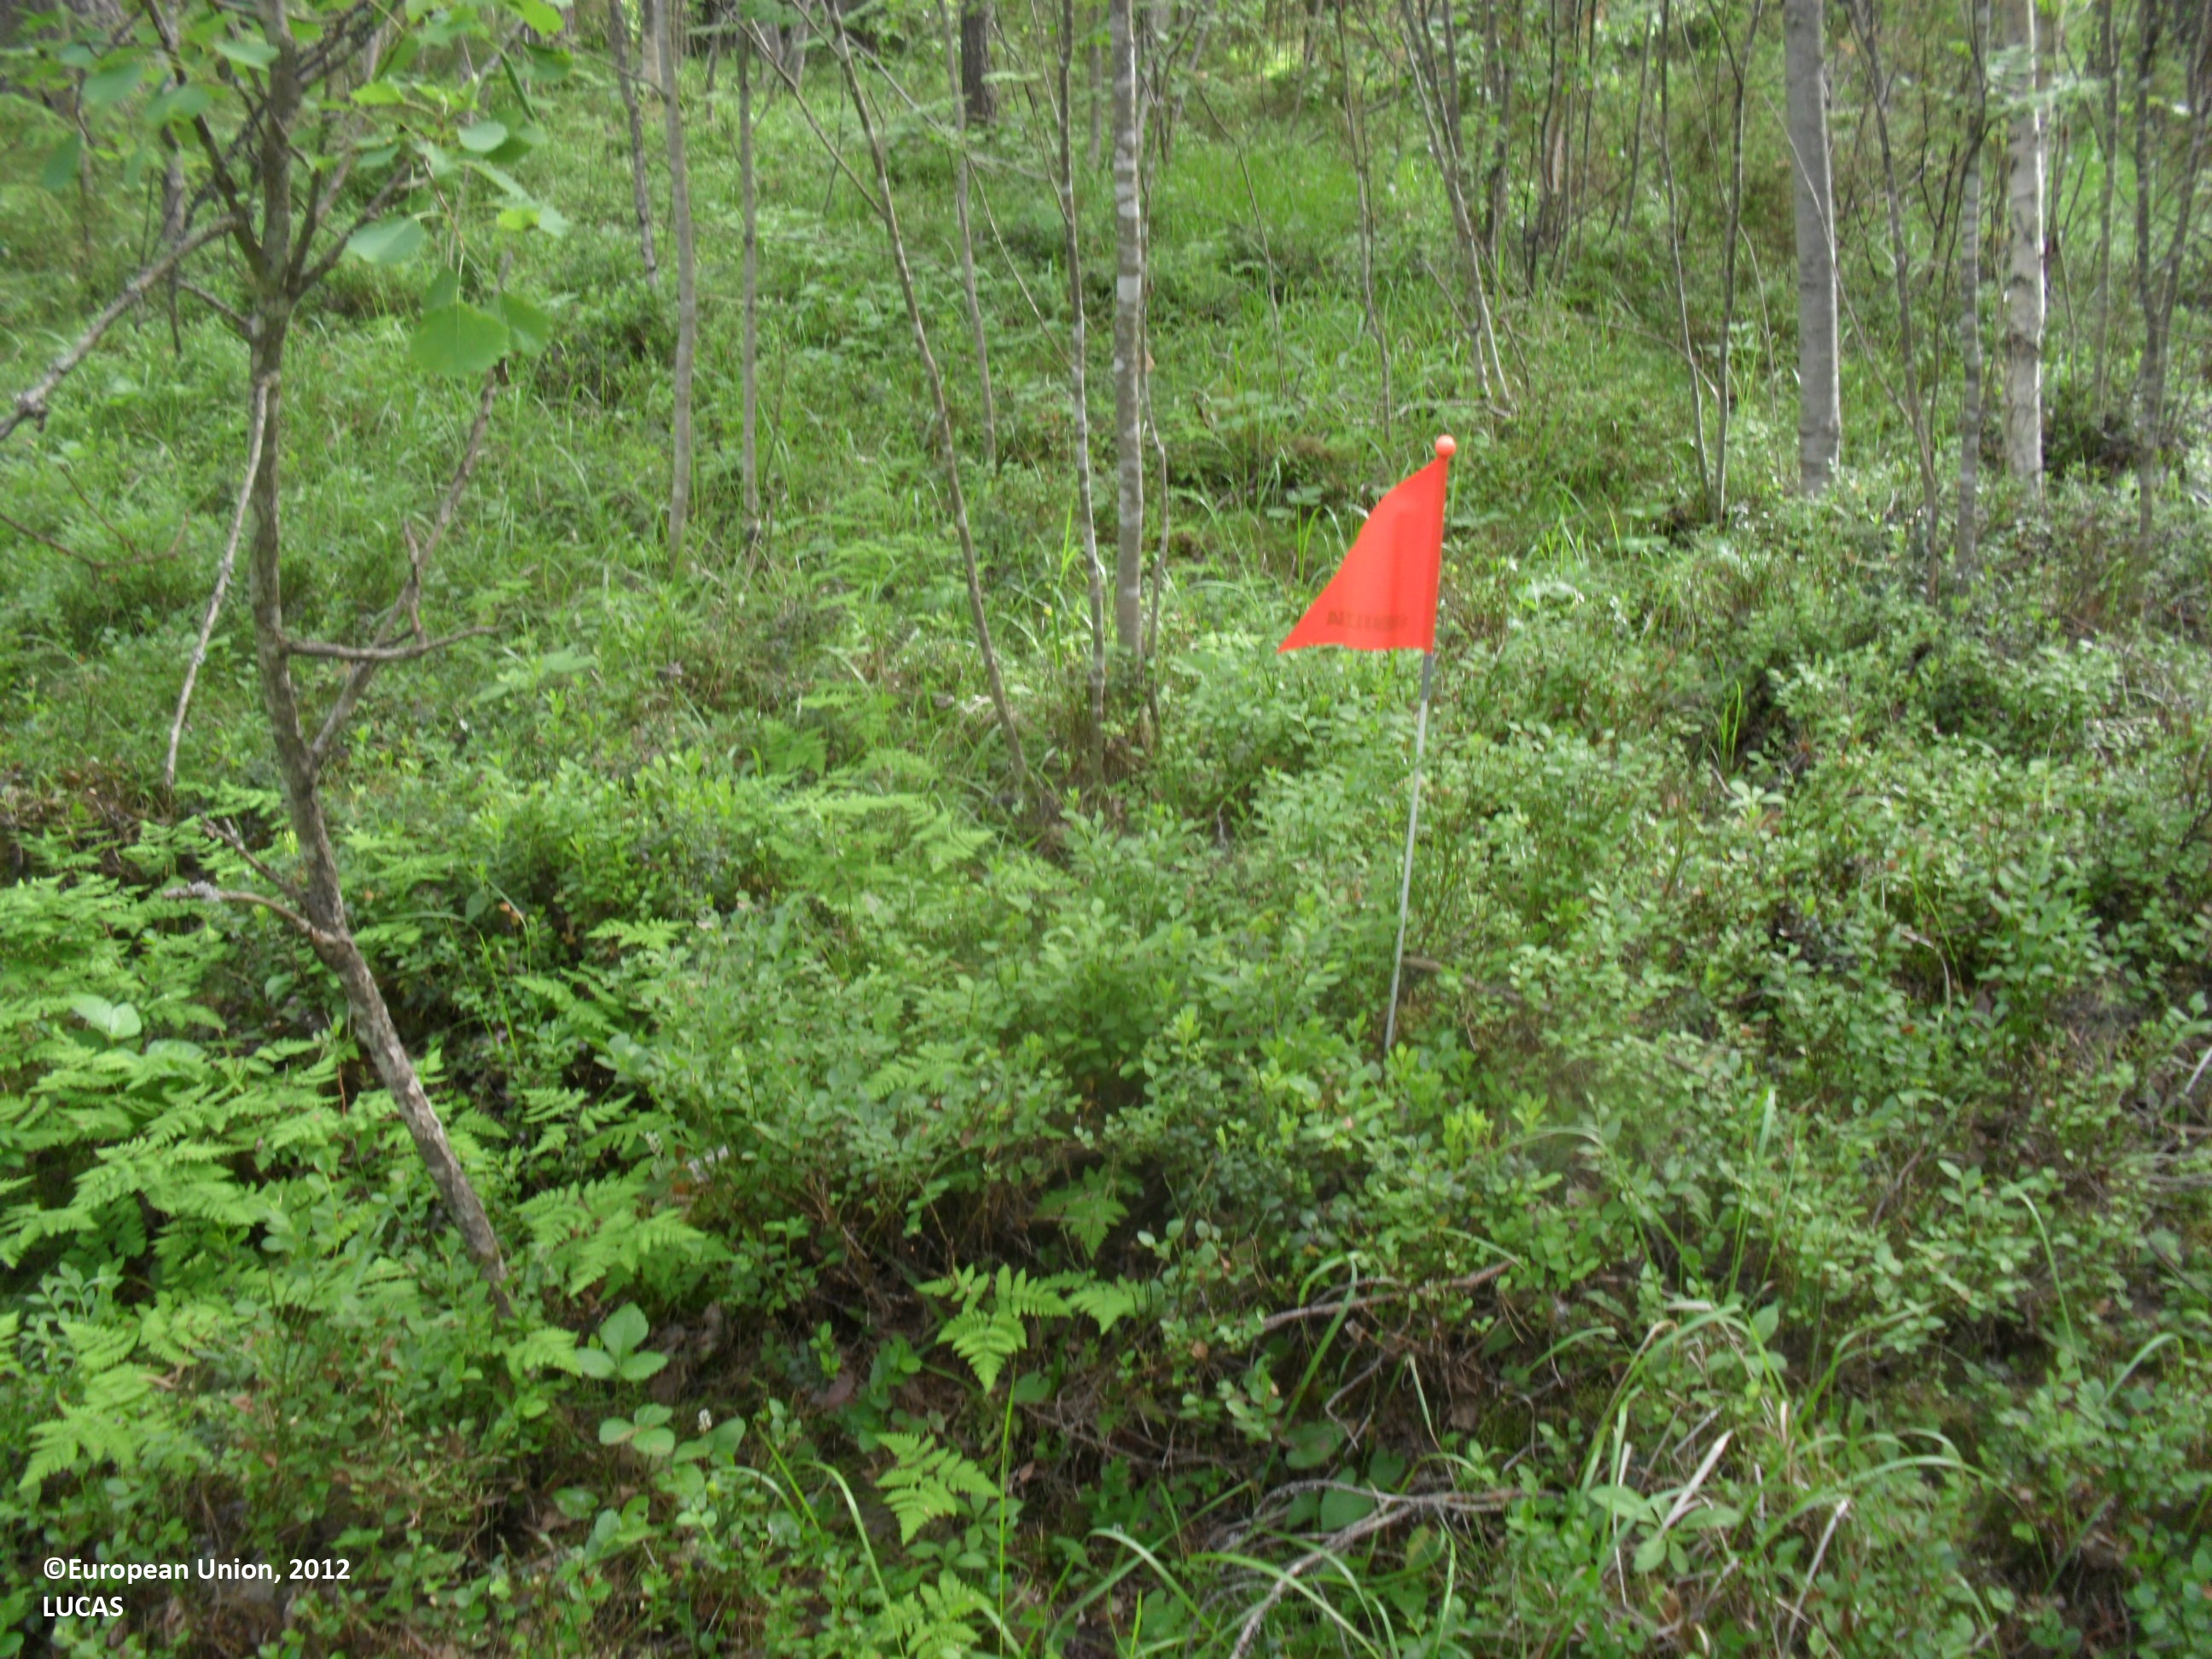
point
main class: Woodland
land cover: Other mixed woodland
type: boreal forest
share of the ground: > 75 %
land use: Forestry
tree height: > 5 m
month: June
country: FI
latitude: 62.8079
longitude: 23.7042
